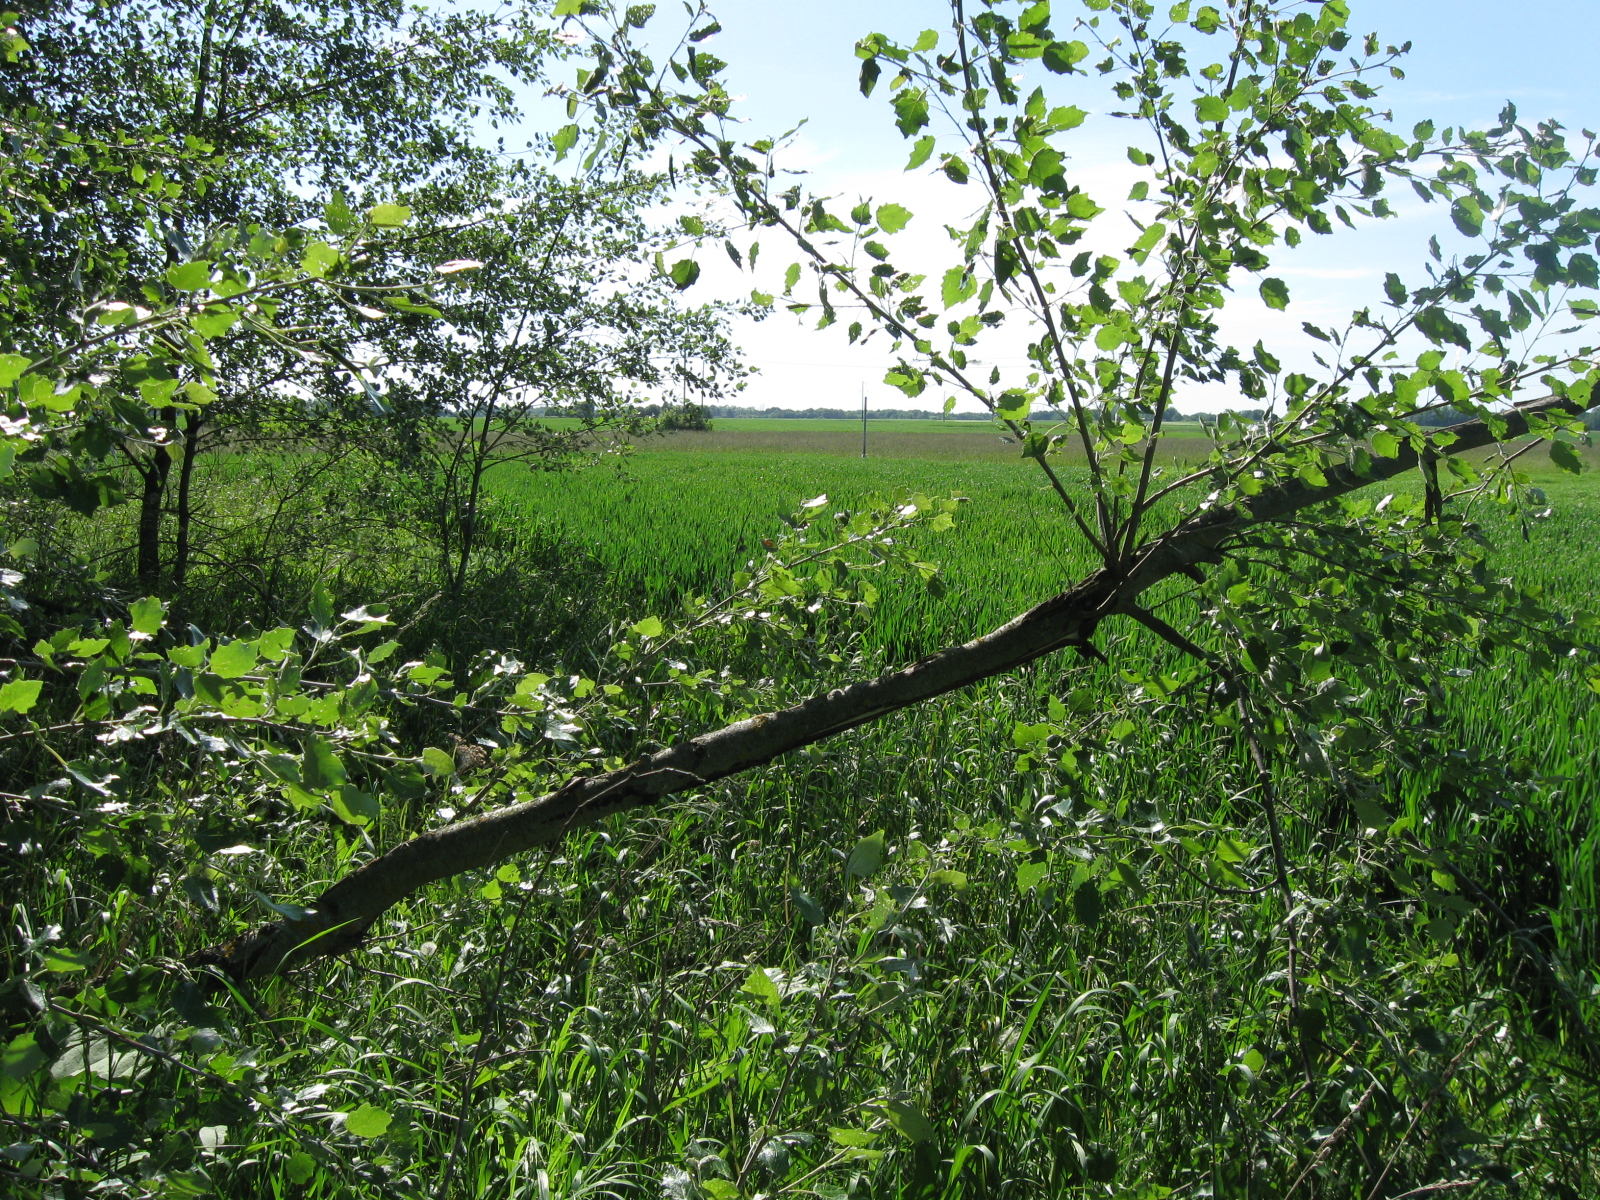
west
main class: Cropland
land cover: Common wheat
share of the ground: > 75 %
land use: Agriculture (excluding fallow land and kitchen gardens)
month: June
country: LT
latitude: 54.8168
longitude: 23.9562
